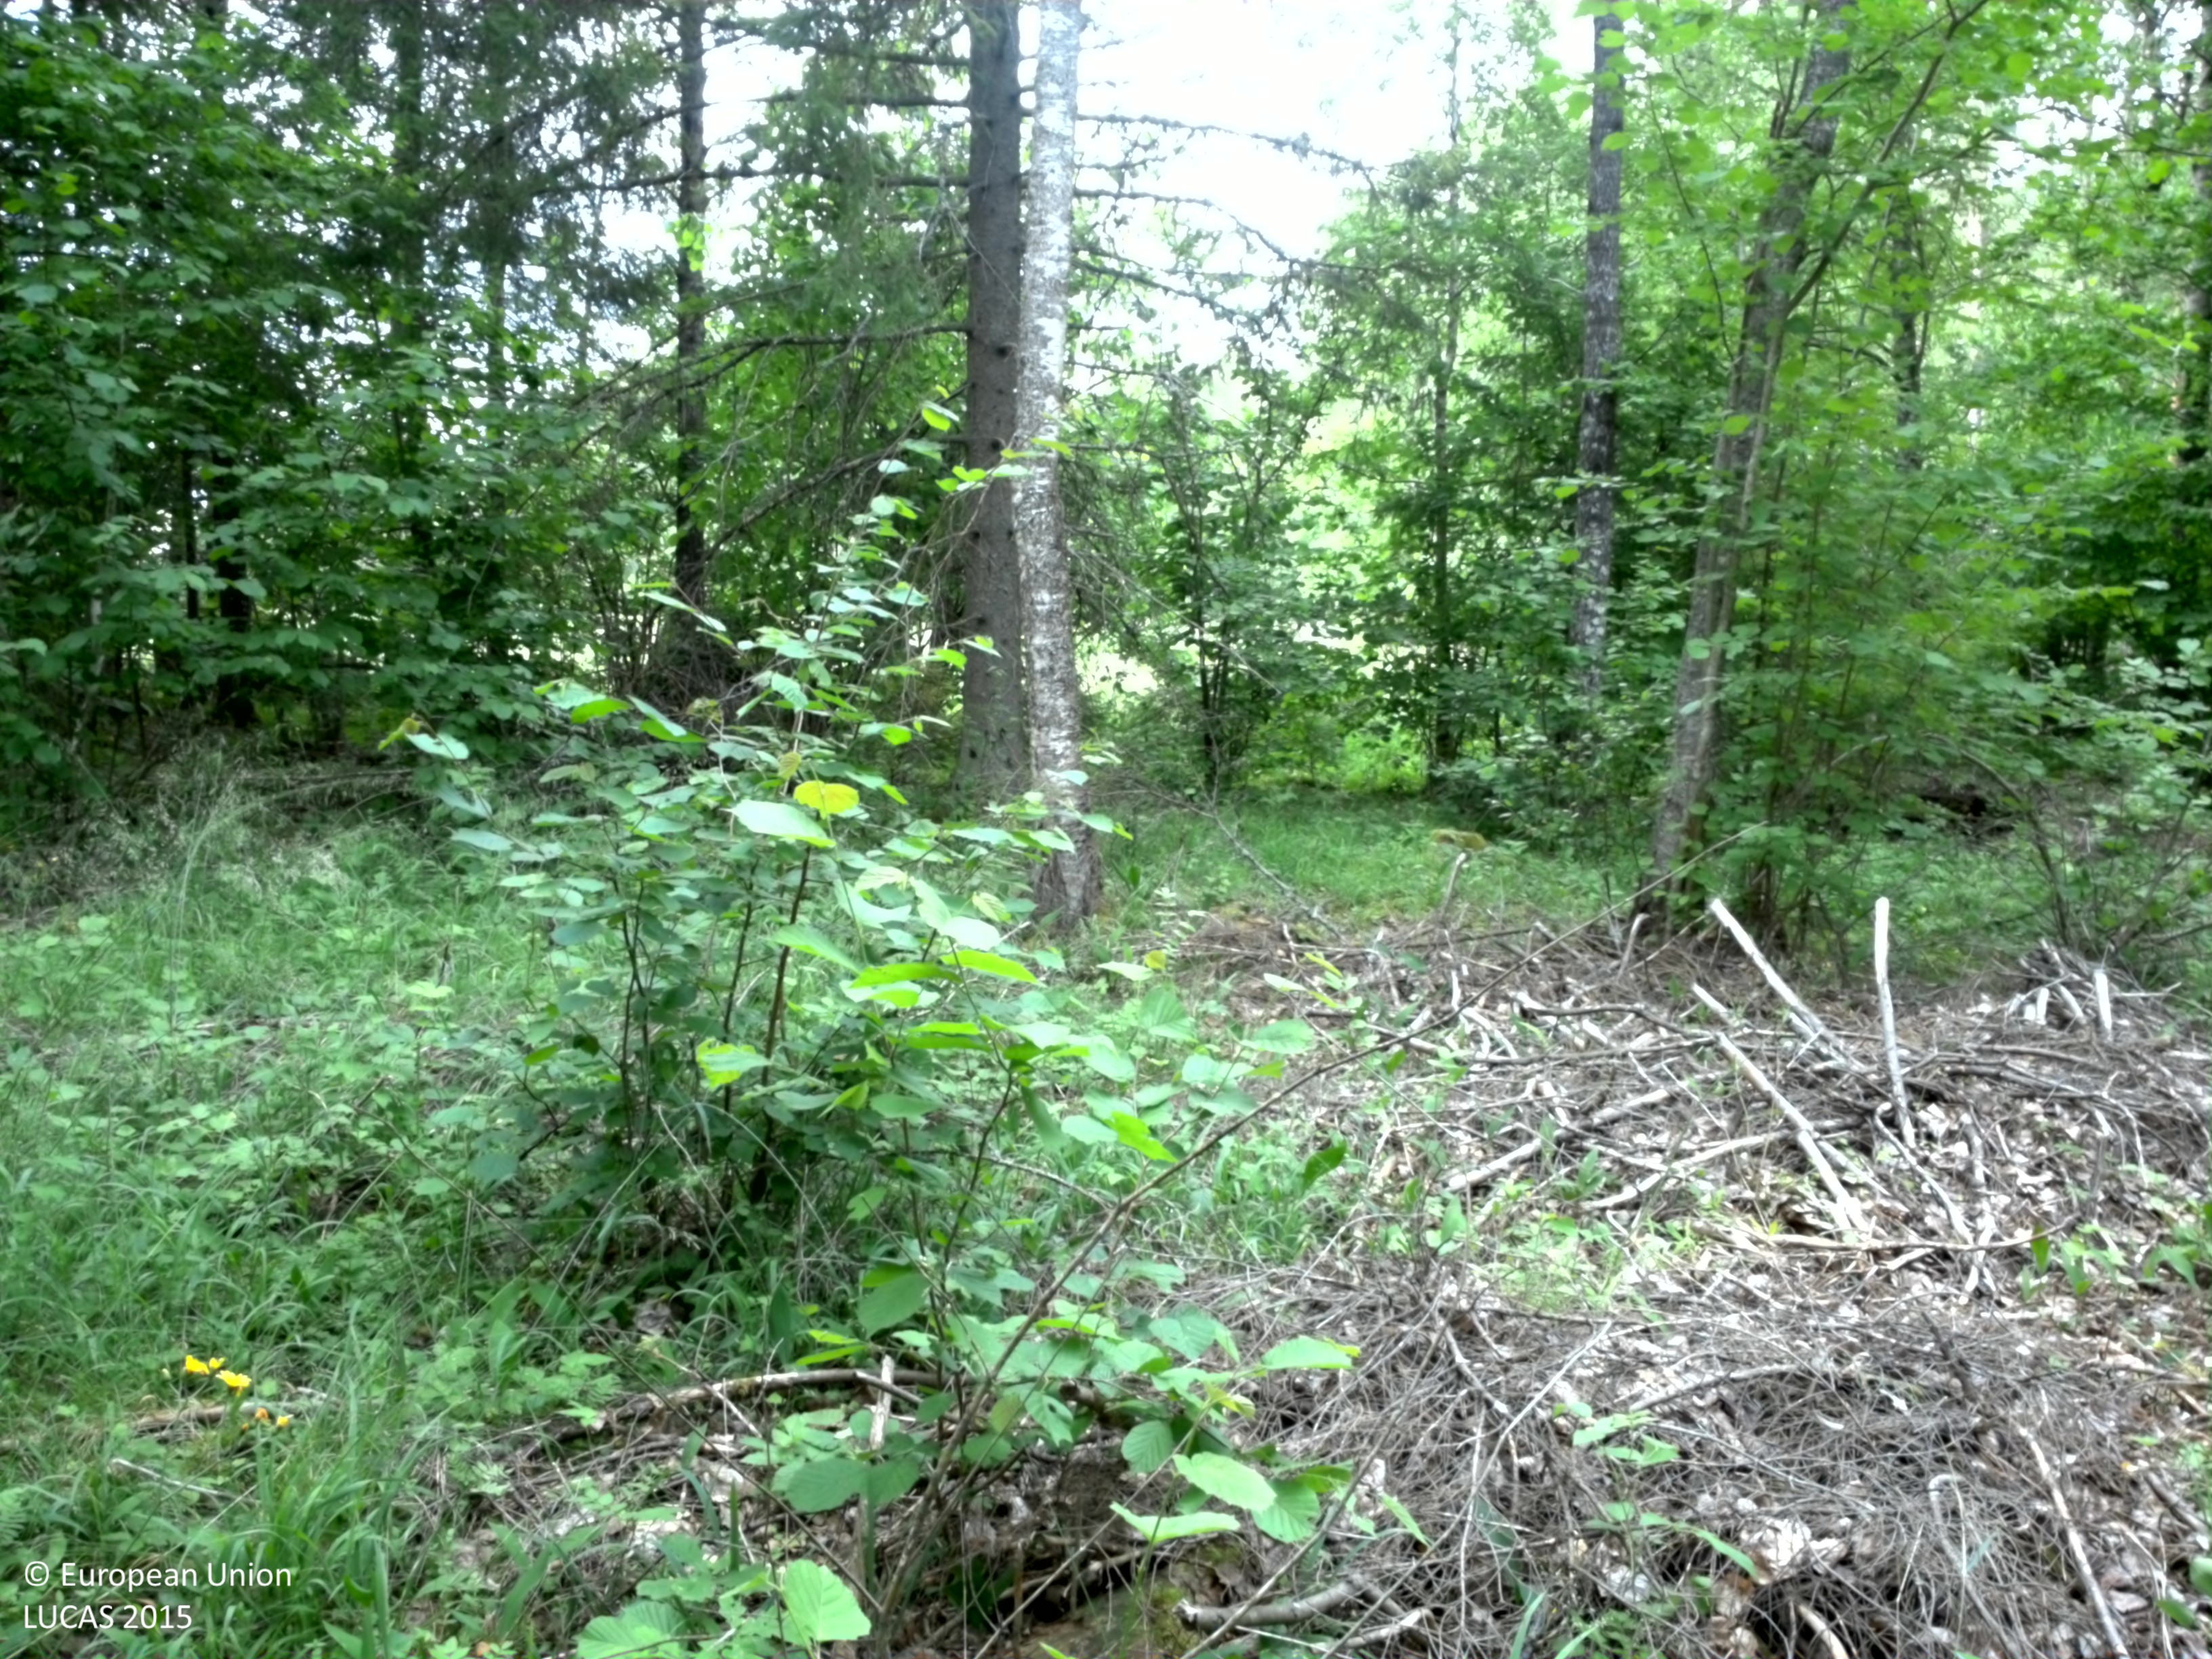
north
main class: Woodland
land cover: Broadleaved woodland
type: hemiboreal forest and nemoral coniferous forest and mixed broadleaved-coniferous forest
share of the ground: > 75 %
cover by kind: broadleaved forest trees 70 %, herbaceous plants 25 %, coniferous forest trees 5 %
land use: Forestry
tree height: > 5 m
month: July
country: SE
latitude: 59.7983
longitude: 17.5329
